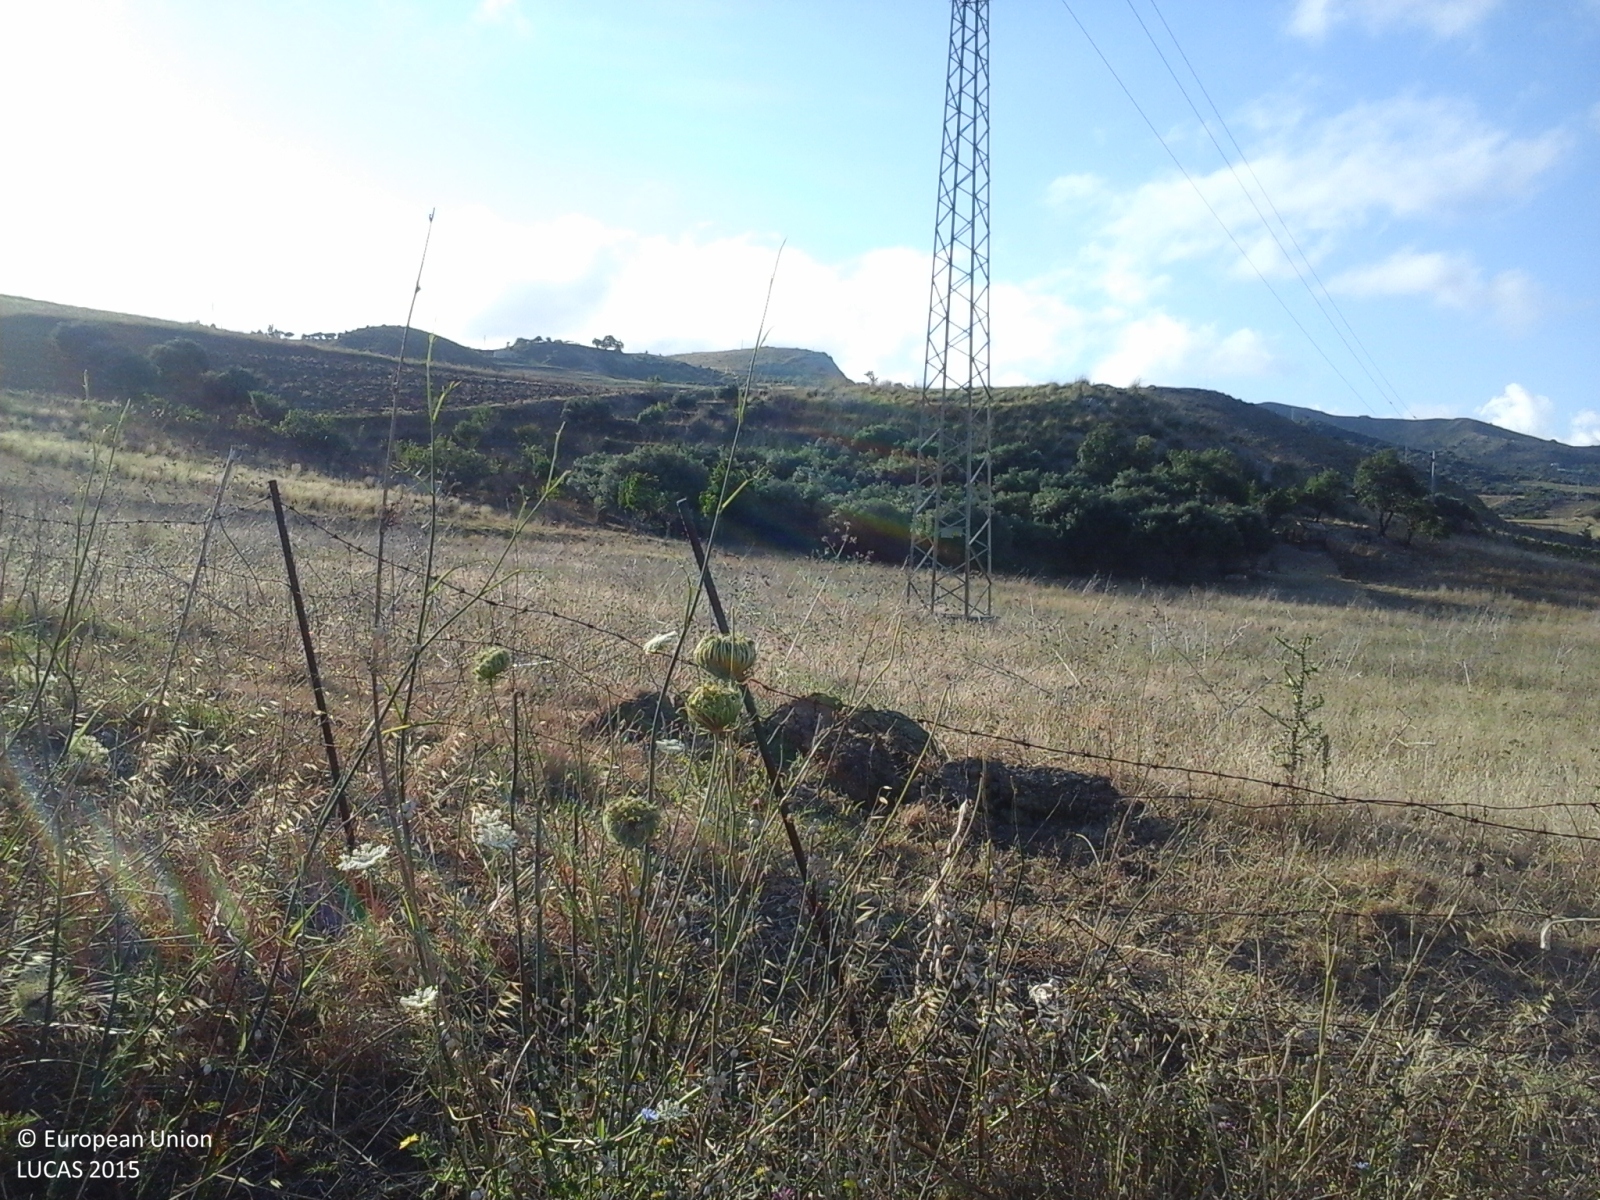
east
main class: Grassland
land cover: Spontaneously vegetated surfaces
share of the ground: > 75 %
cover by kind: herbaceous plants 100 %
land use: Fallow land
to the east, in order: Spontaneously vegetated surfaces; Electric lines; Spontaneously vegetated surfaces; Olive groves; Fences; Spontaneously vegetated surfaces
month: June
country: IT
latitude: 37.9257
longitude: 13.8069
